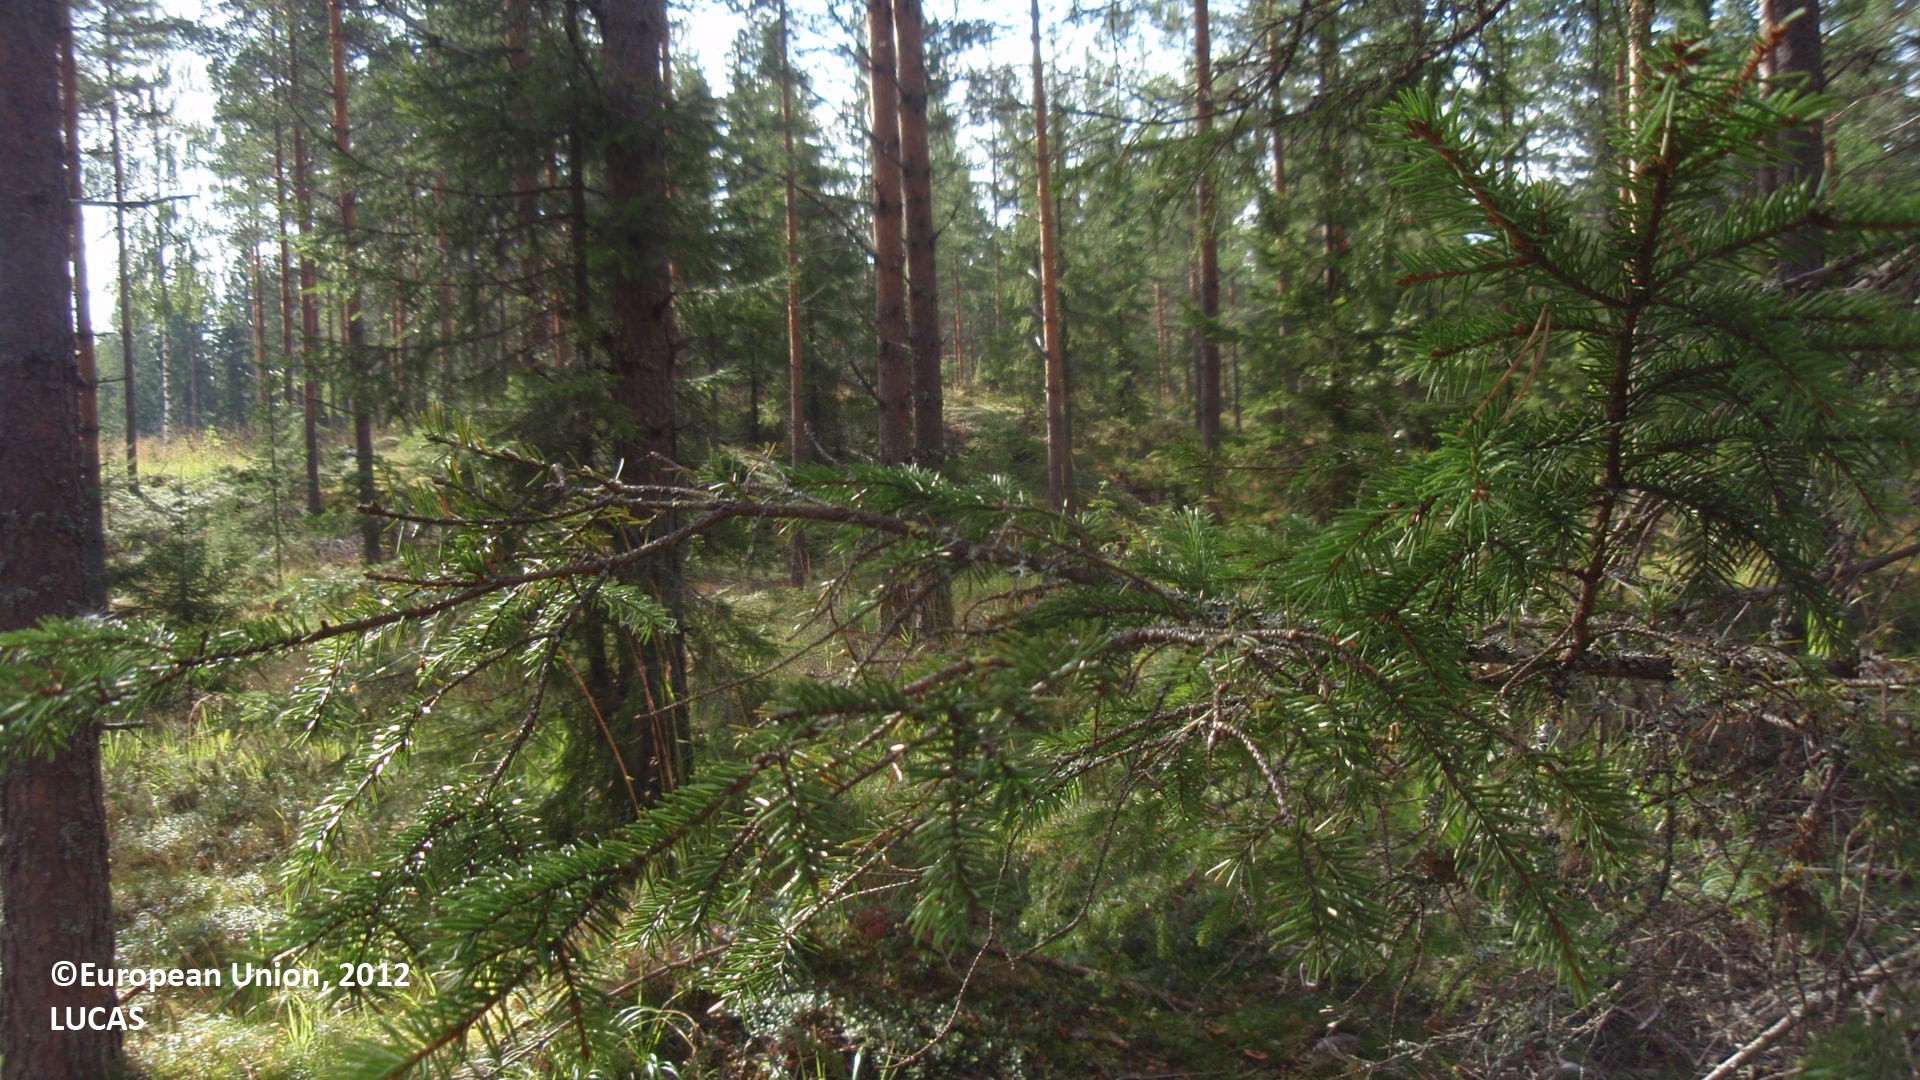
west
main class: Woodland
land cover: Pine dominated mixed woodland
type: boreal forest
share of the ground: 50 - 75 %
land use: Forestry
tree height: > 5 m
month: August
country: FI
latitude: 61.6329
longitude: 27.0095
